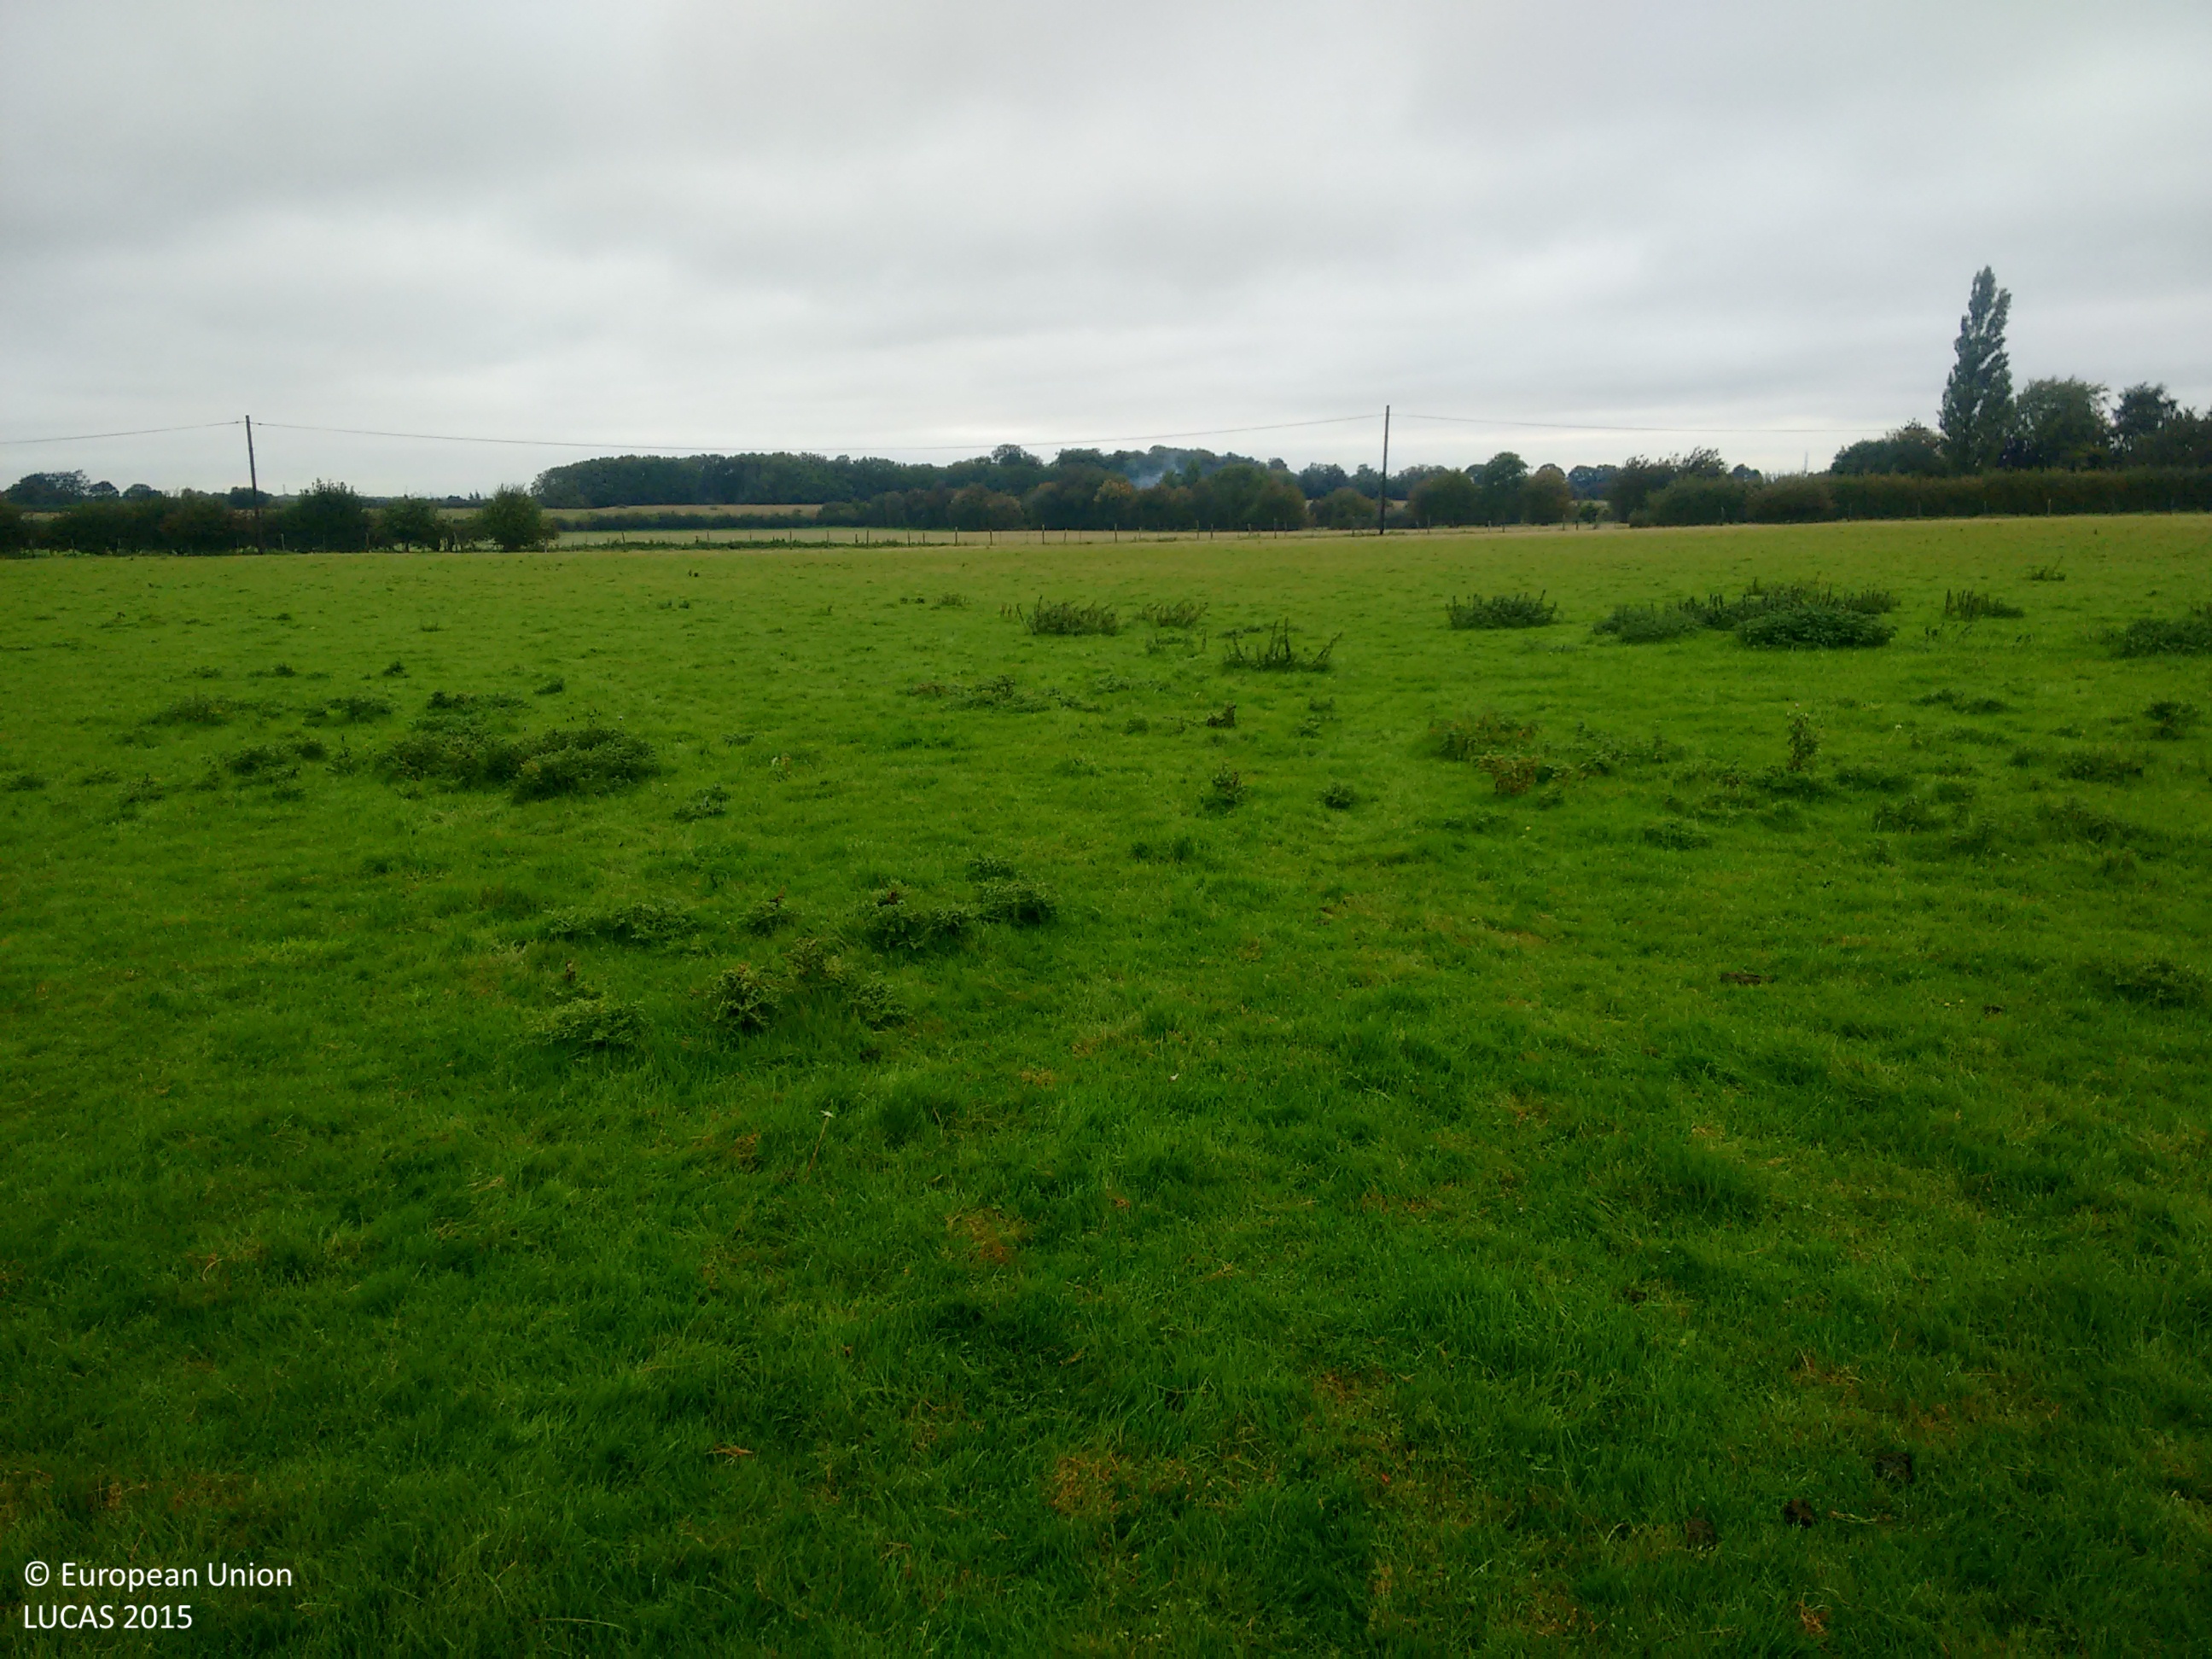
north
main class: Grassland
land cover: Grassland without tree/shrub cover
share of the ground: > 75 %
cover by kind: herbaceous plants 100 %
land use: Agriculture (excluding fallow land and kitchen gardens)
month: October
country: GB
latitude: 51.3185
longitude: 0.6325
